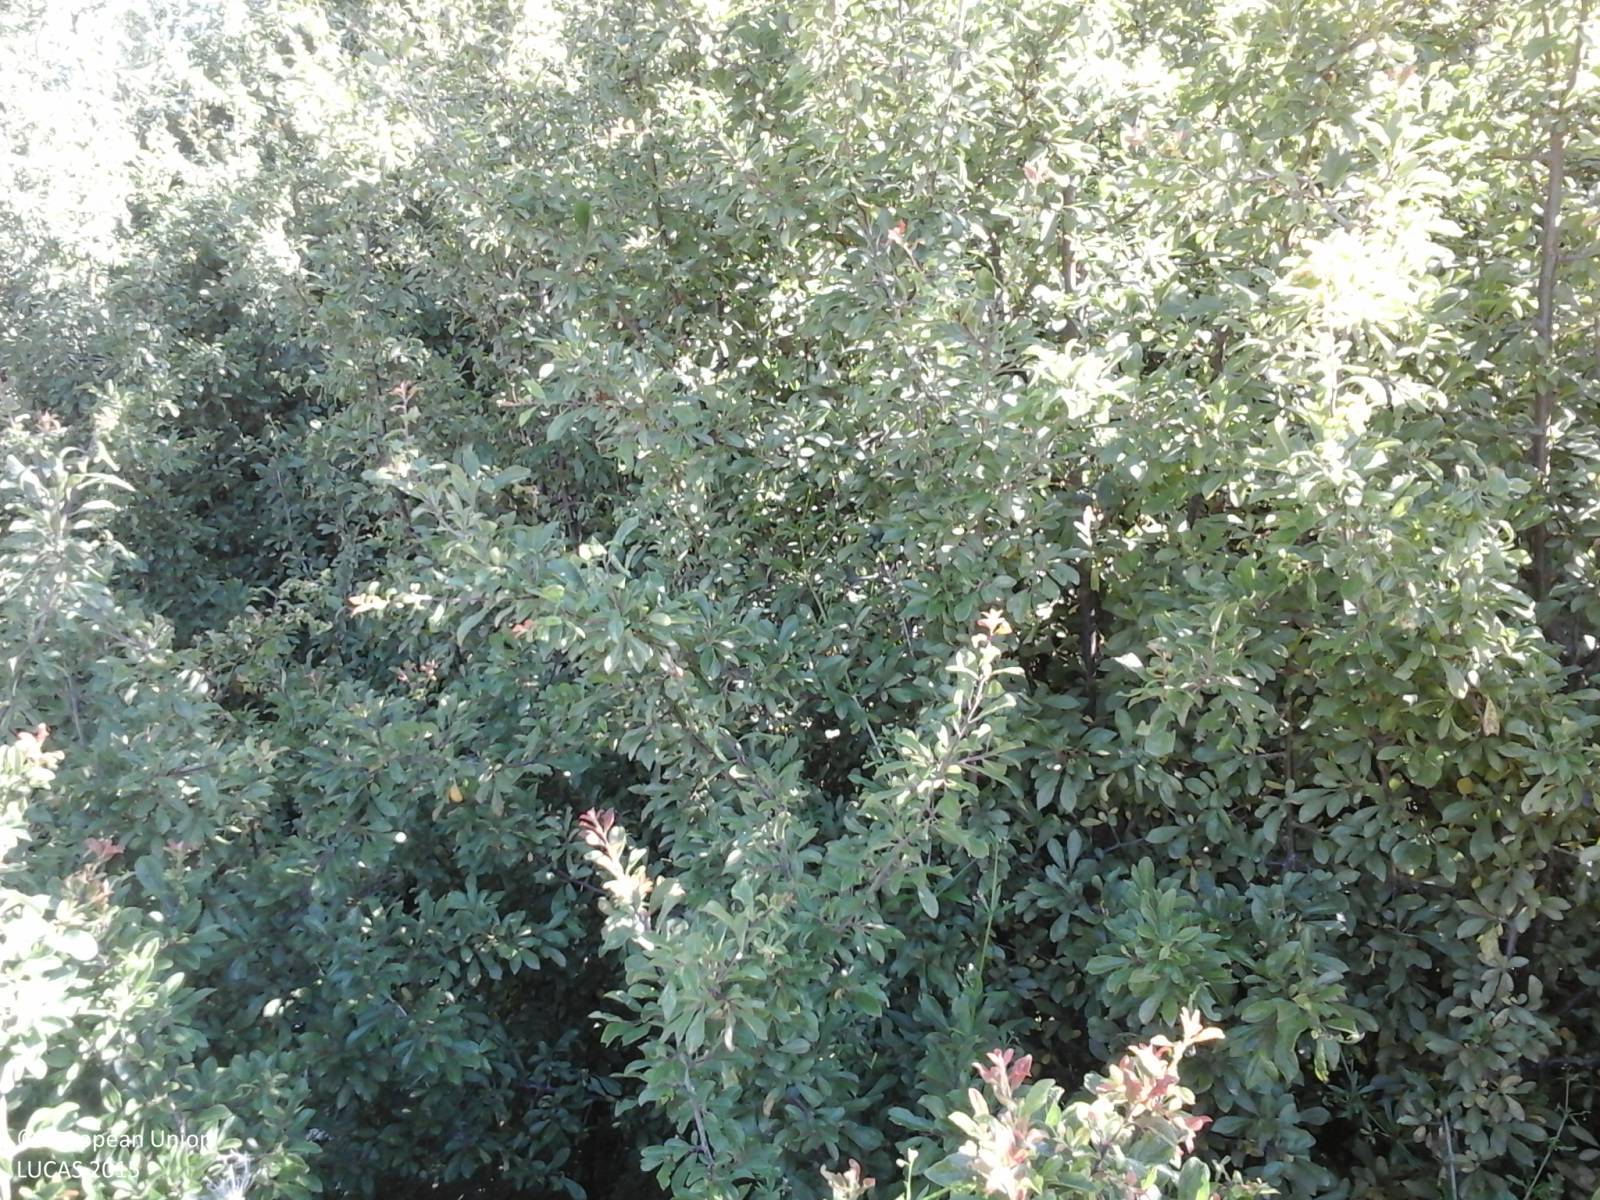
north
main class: Shrubland
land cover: Shrubland without tree cover
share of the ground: > 75 %
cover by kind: shrubs 100 %
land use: Semi-natural and natural areas not in use
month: July
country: IT
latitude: 42.4899
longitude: 13.3596
